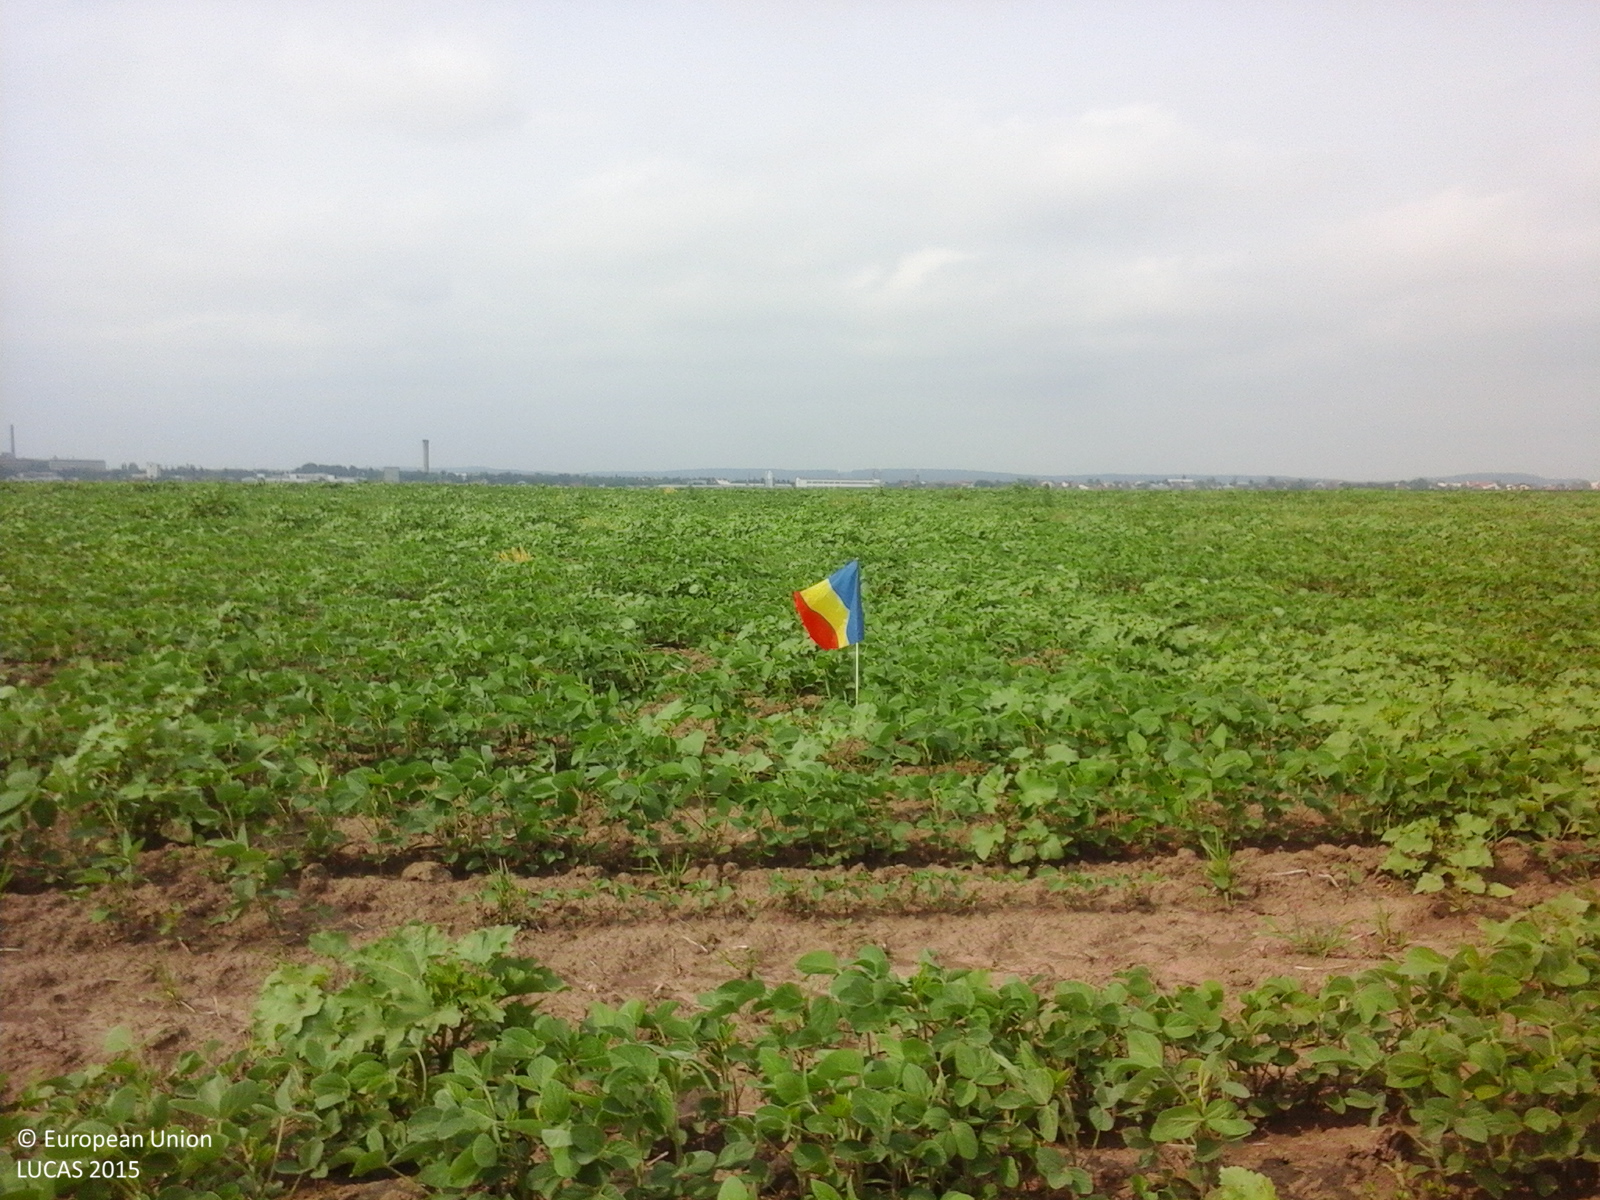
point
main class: Cropland
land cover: Soya
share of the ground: 50 - 75 %
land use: Agriculture (excluding fallow land and kitchen gardens)
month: June
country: RO
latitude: 47.7754
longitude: 26.6287
